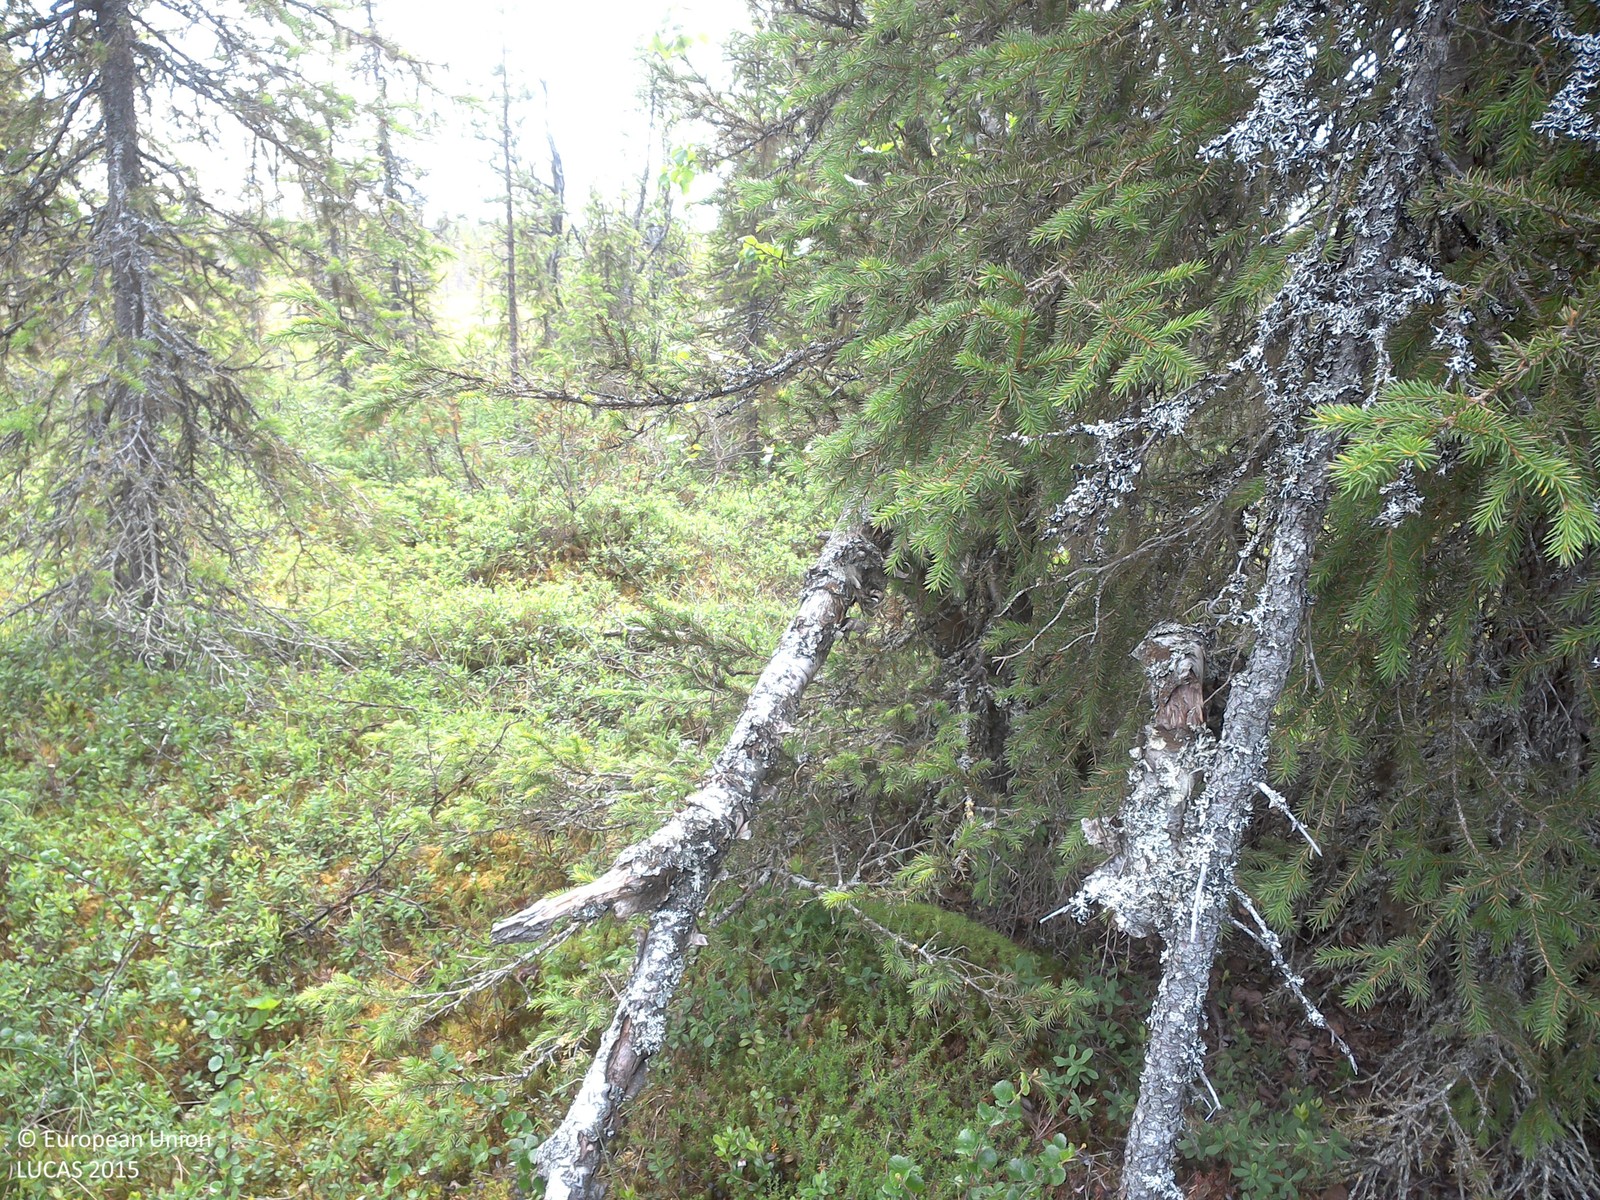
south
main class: Woodland
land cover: Spruce dominated mixed woodland
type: boreal forest
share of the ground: 25 - 50 %
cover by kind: shrubs 55 %, coniferous forest trees 25 %, broadleaved forest trees 10 %, lichens and mosses 10 %
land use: Forestry
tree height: > 5 m
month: July
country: SE
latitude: 67.6121
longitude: 23.4957
